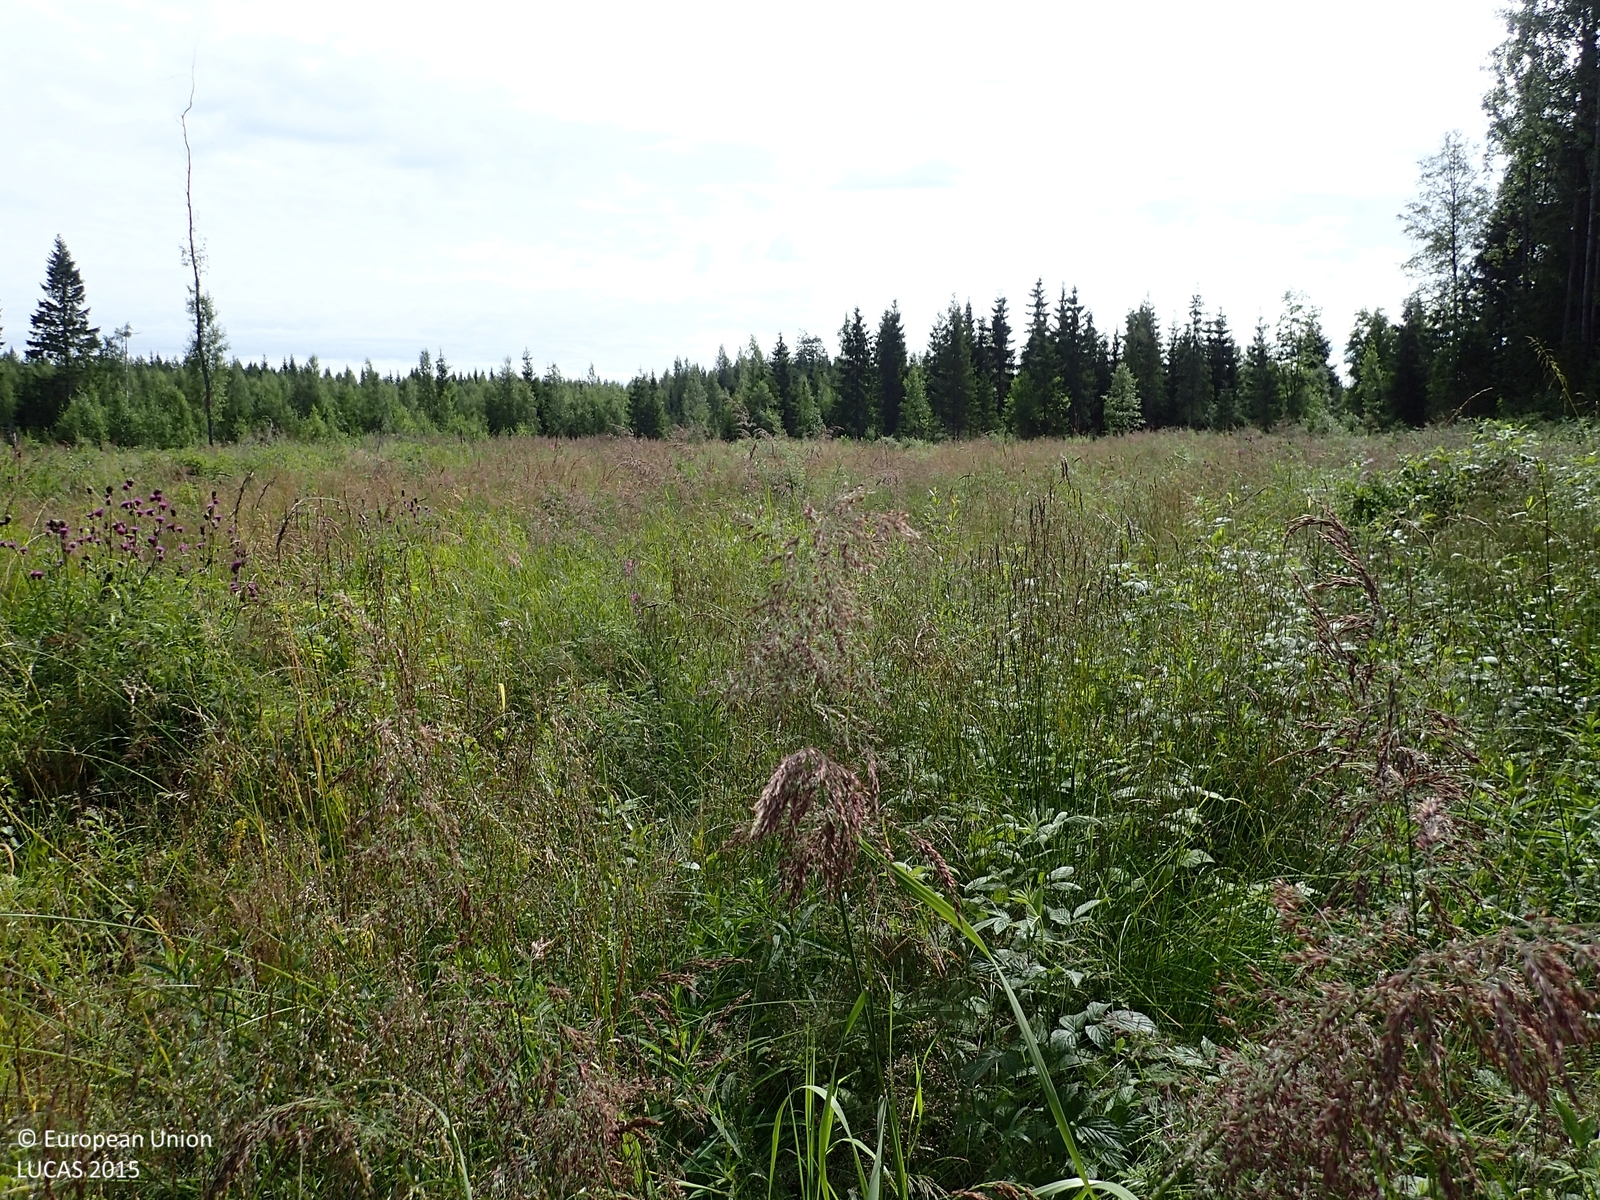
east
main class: Grassland
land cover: Grassland with sparse tree/shrub cover
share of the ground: > 75 %
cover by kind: herbaceous plants 95 %, broadleaved forest trees 5 %
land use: Forestry
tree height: < 5 m
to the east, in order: Grassland with sparse tree/shrub cover; Broadleaved woodland; Ditches and canals; Broadleaved woodland; Ditches and canals; Spruce dominated mixed woodland; Ditches and canals; Spruce dominated mixed woodland
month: July
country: FI
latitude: 62.9341
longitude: 22.6819
